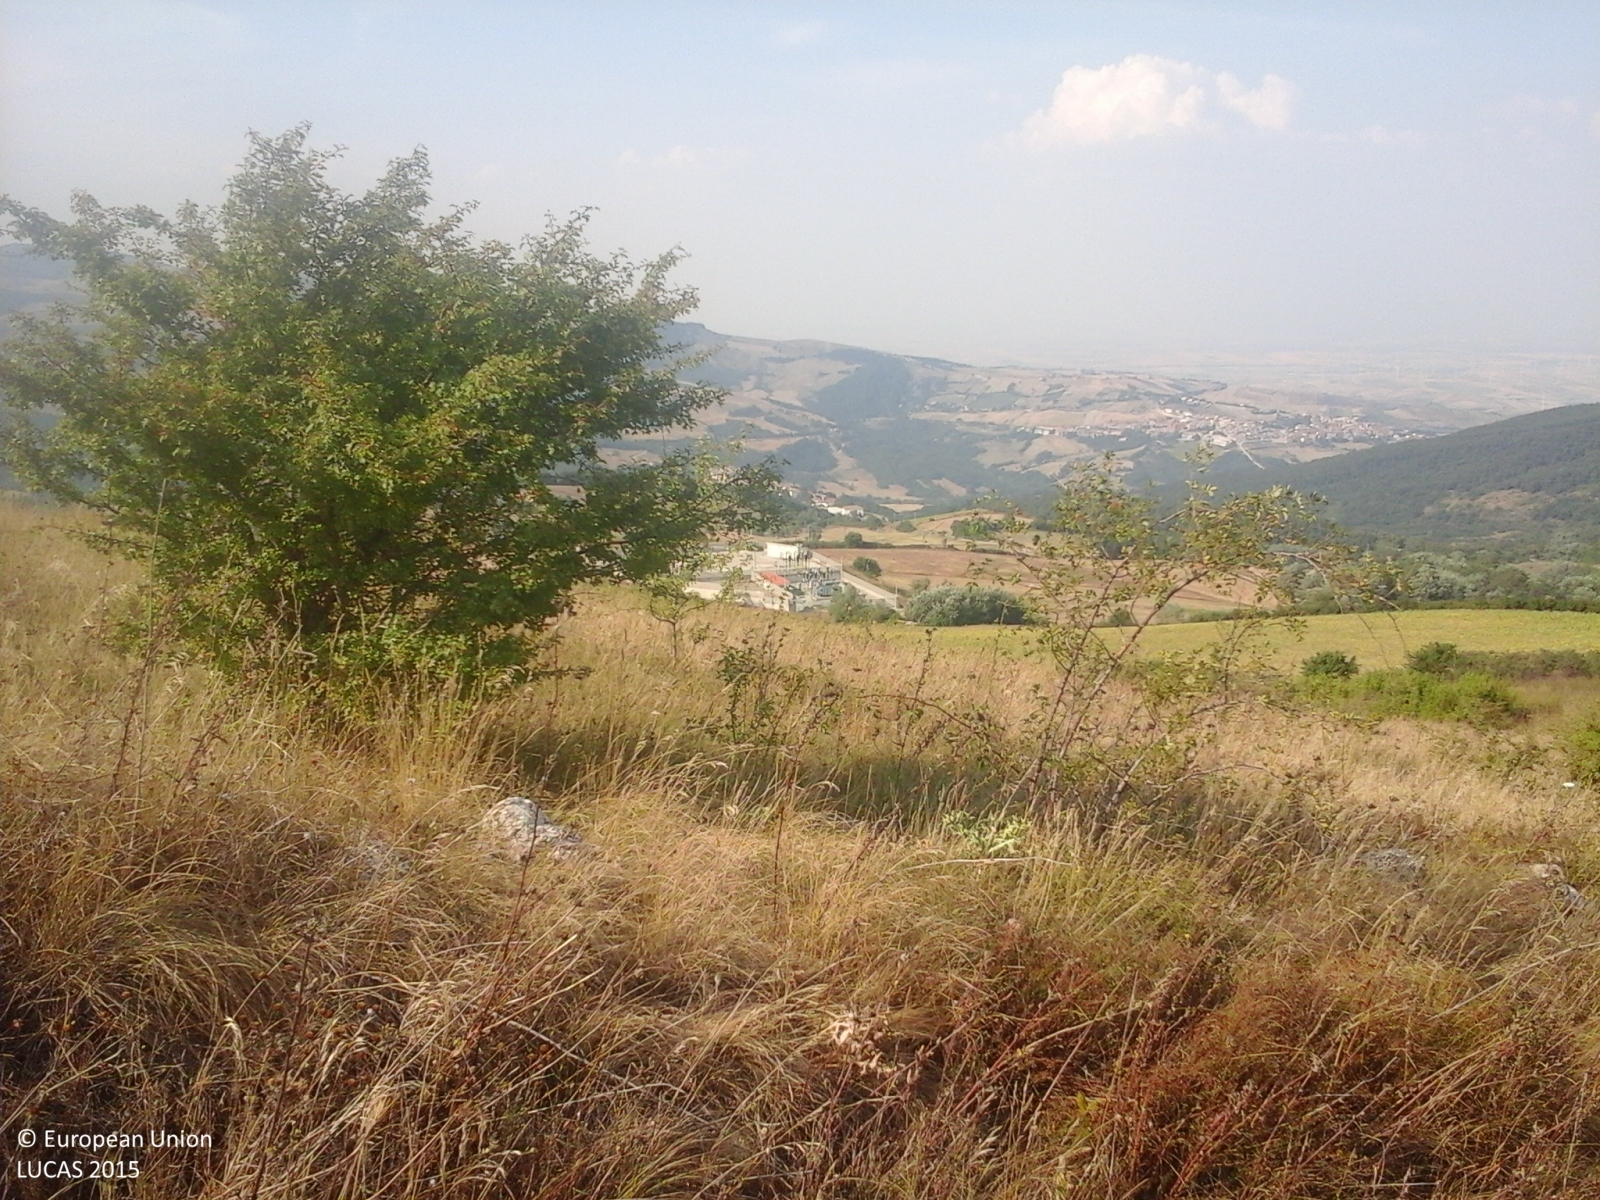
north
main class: Grassland
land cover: Spontaneously vegetated surfaces
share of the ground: > 75 %
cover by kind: herbaceous plants 100 %
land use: Abandoned areas
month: August
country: IT
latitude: 41.3087
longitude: 15.1776
